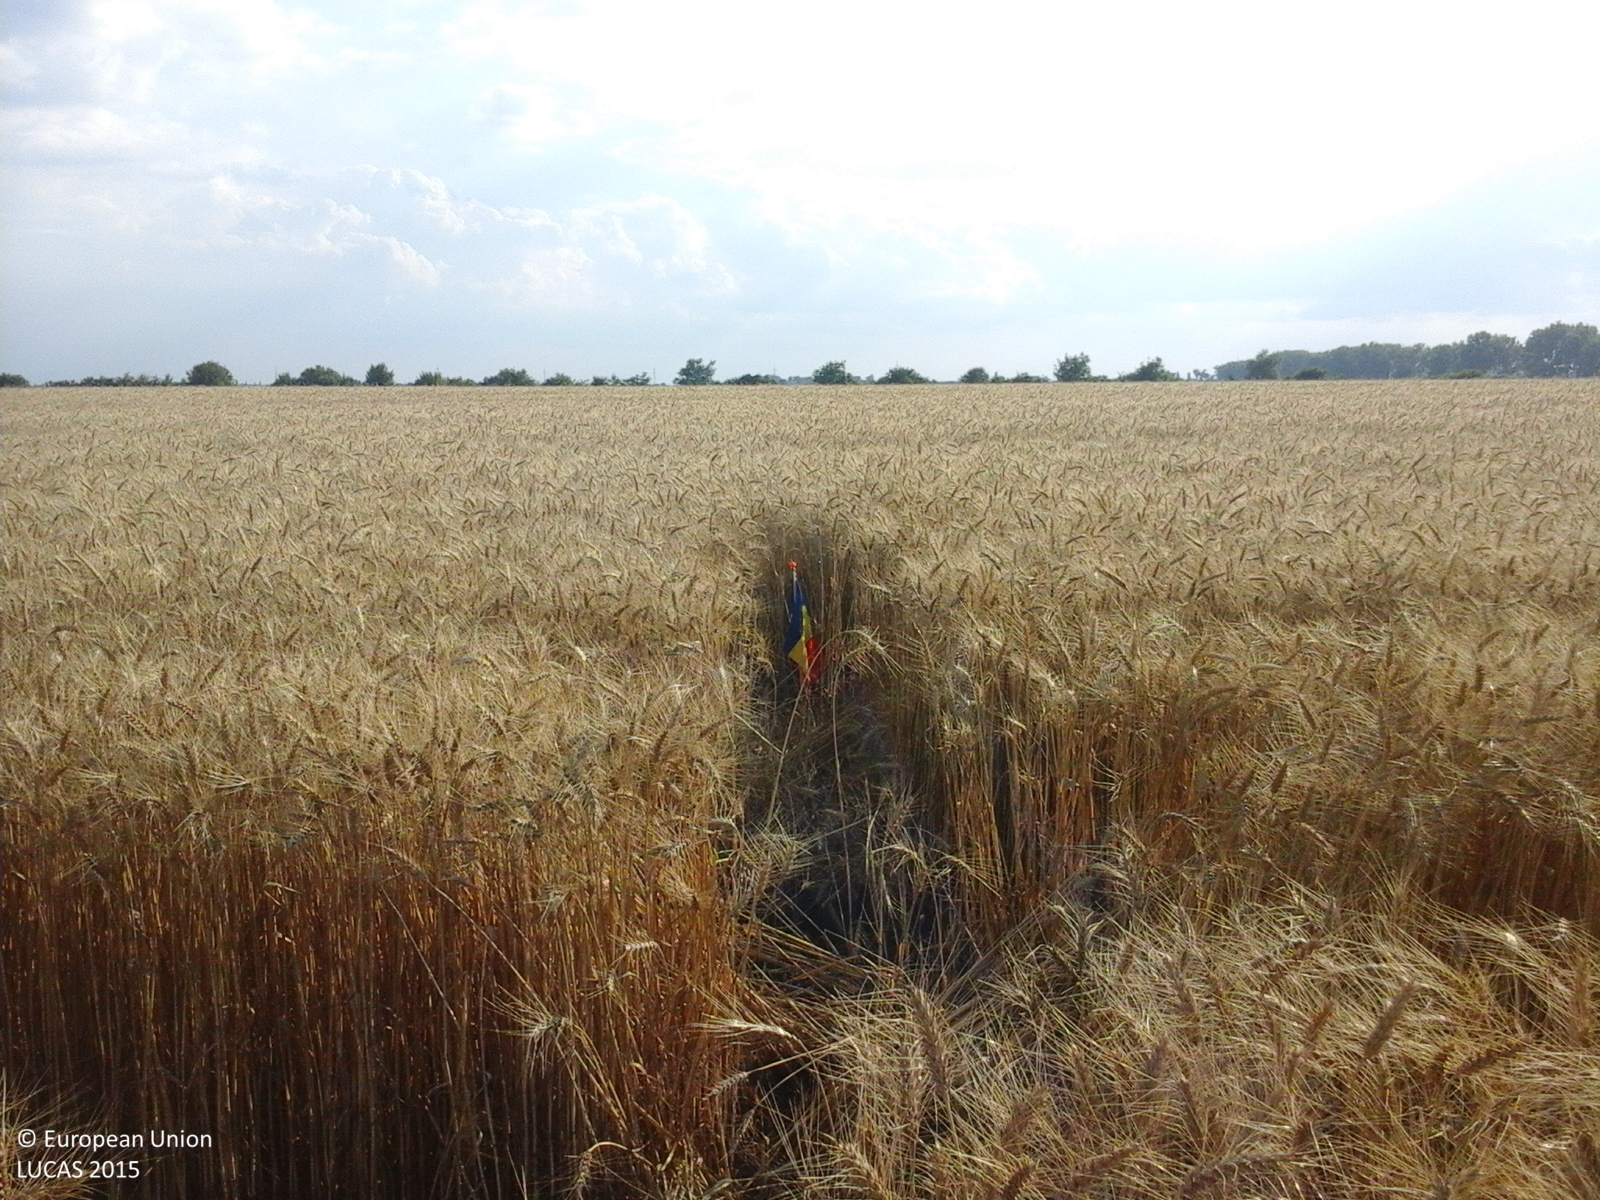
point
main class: Cropland
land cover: Common wheat
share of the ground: > 75 %
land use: Agriculture (excluding fallow land and kitchen gardens)
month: June
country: RO
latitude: 44.5707
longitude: 25.9824
